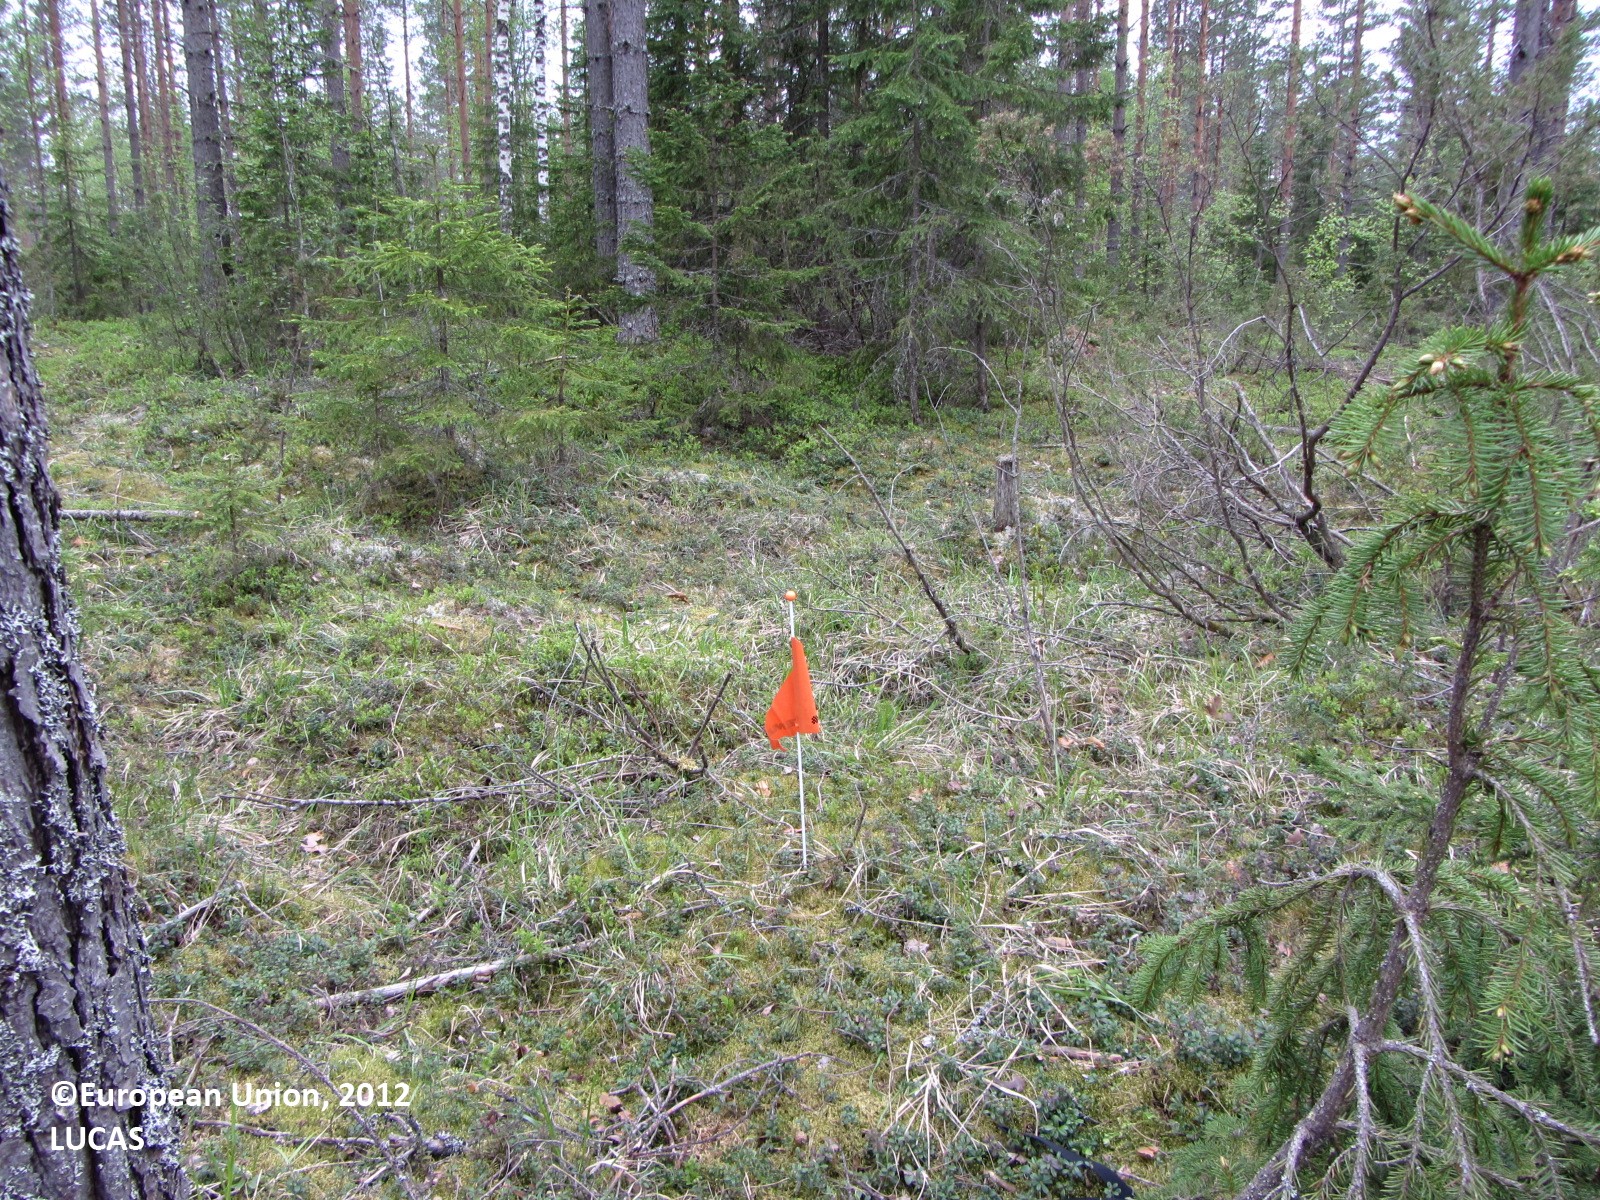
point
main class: Woodland
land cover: Pine dominated mixed woodland
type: boreal forest
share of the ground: > 75 %
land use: Forestry
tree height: > 5 m
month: May
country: FI
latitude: 62.3314
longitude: 25.3798
